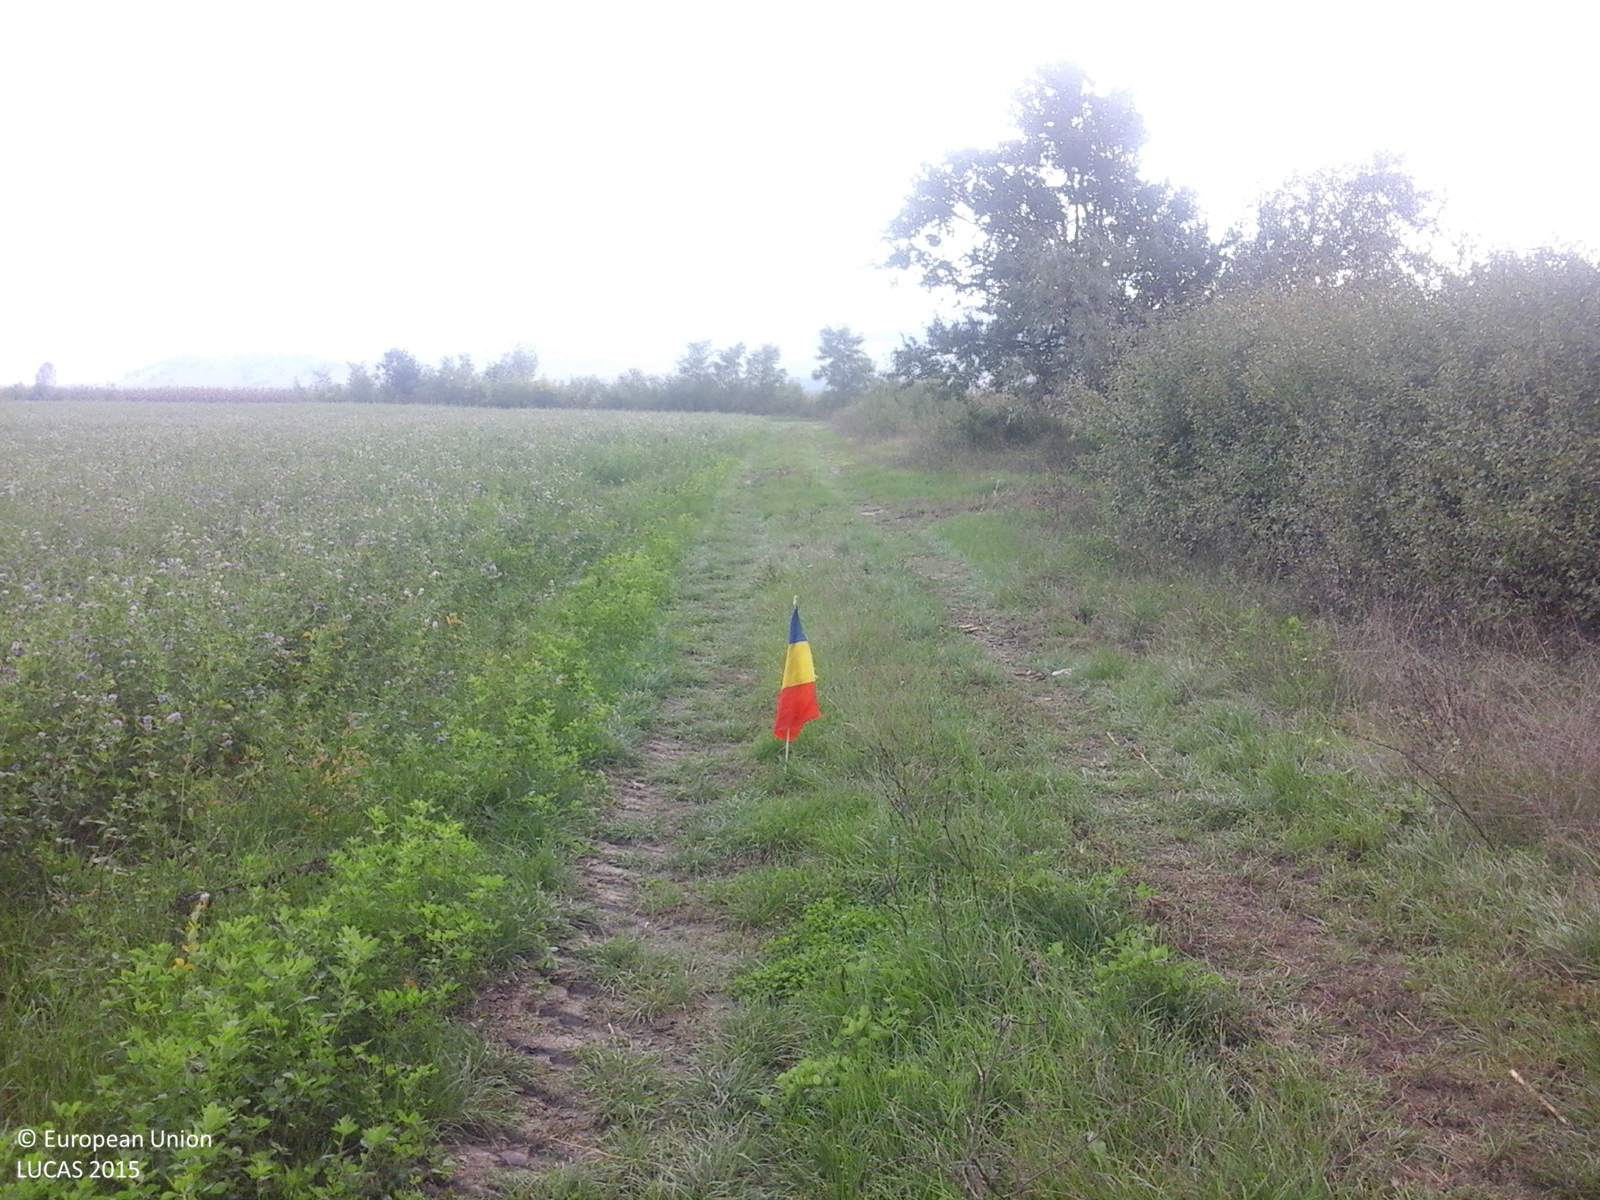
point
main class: Cropland
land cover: Lucerne
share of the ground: > 75 %
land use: Agriculture (excluding fallow land and kitchen gardens)
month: October
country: RO
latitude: 46.1567
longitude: 23.5726
